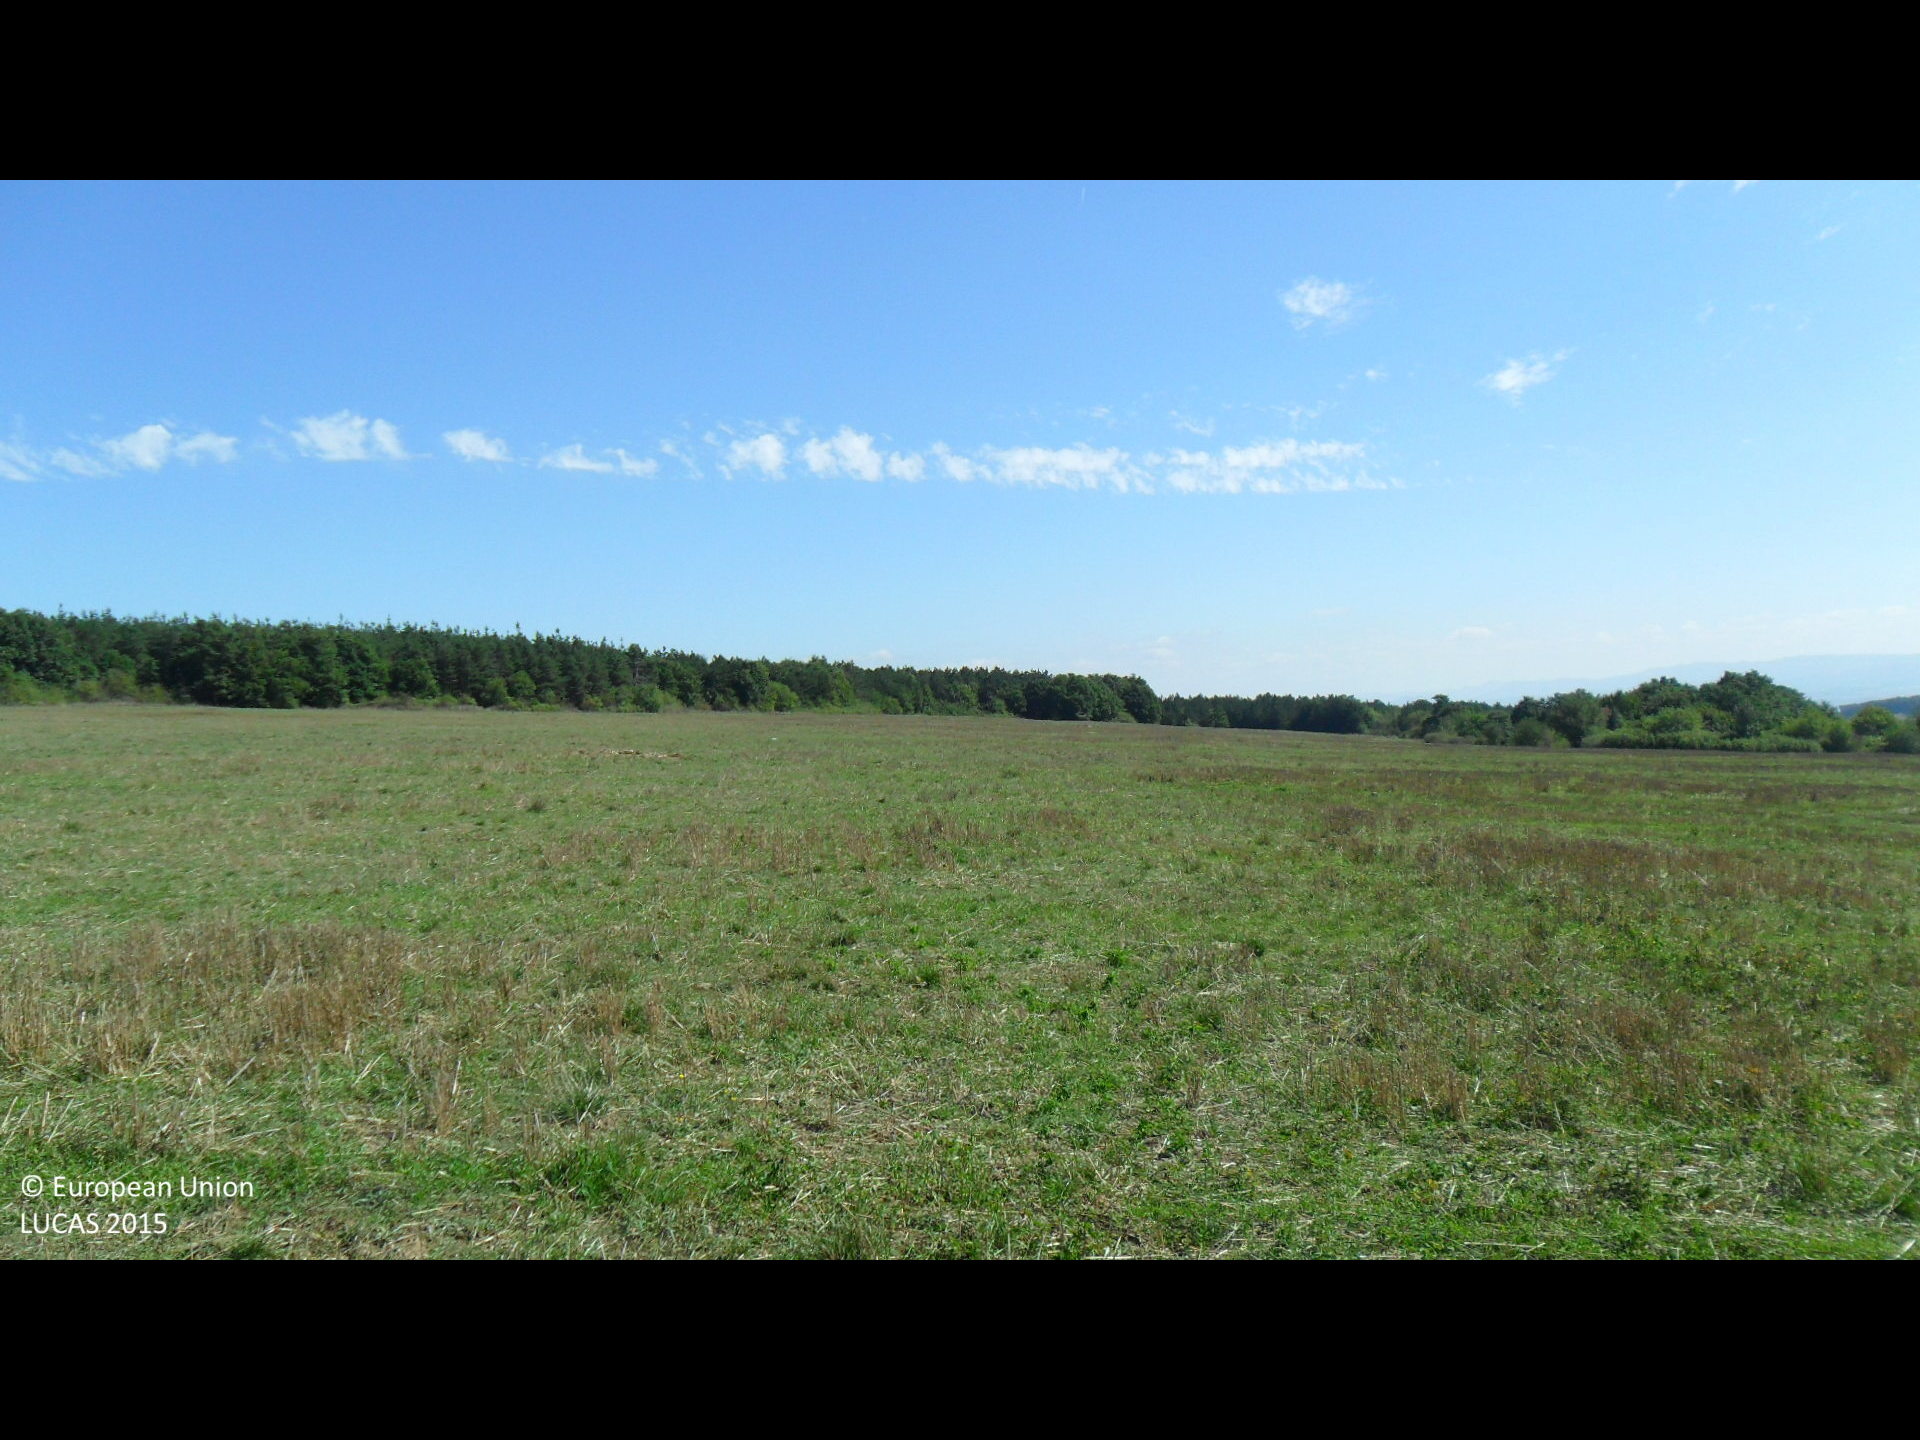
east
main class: Cropland
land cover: Barley
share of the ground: < 10 %
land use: Agriculture (excluding fallow land and kitchen gardens)
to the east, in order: Barley
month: September
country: BG
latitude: 43.0842
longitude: 26.5484
